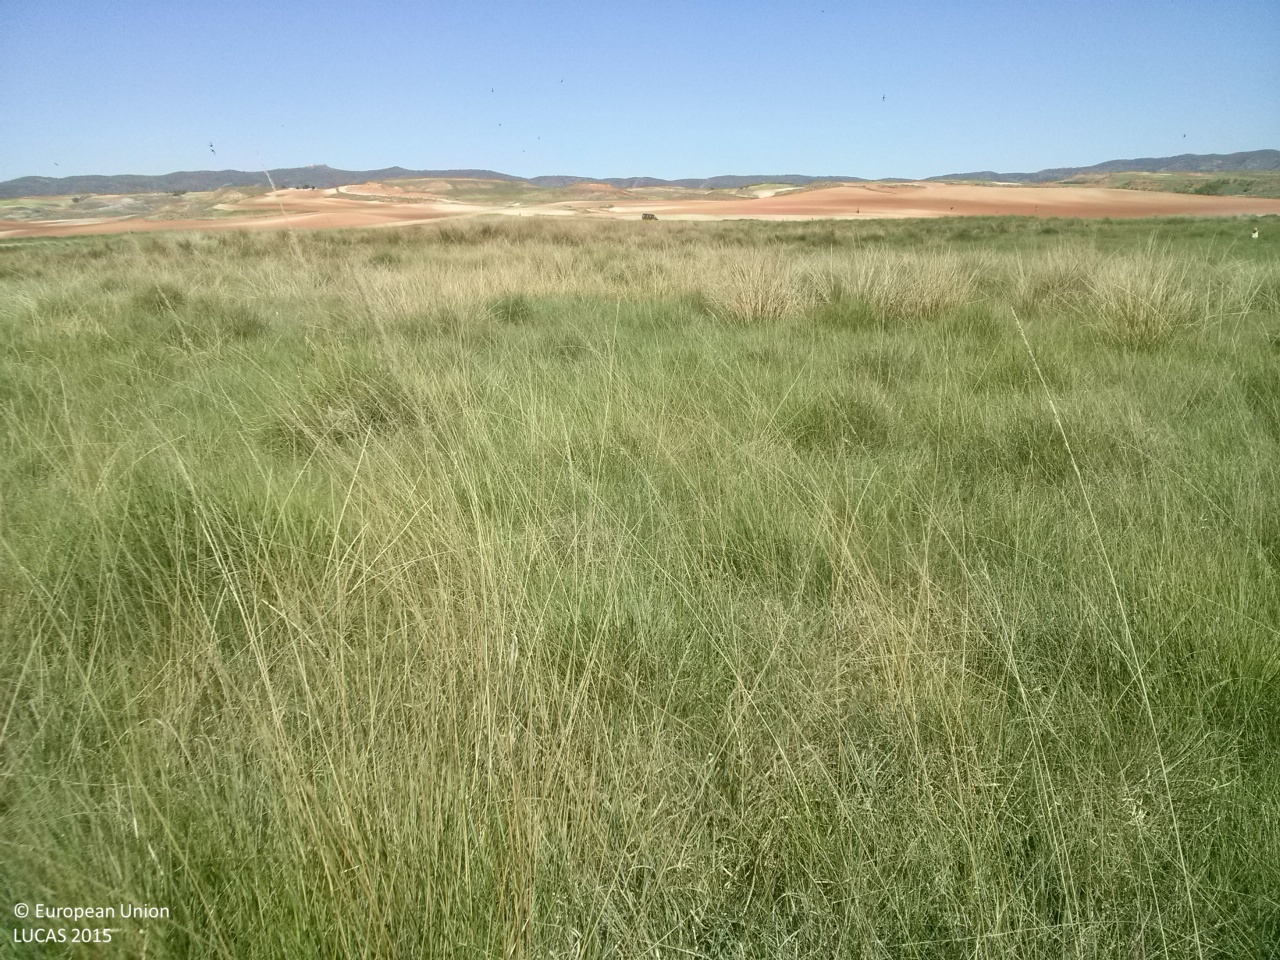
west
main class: Grassland
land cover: Grassland without tree/shrub cover
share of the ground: > 75 %
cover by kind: herbaceous plants 100 %
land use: Semi-natural and natural areas not in use
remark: Temporary flooded
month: May
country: ES
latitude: 40.1827
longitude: -2.7425
